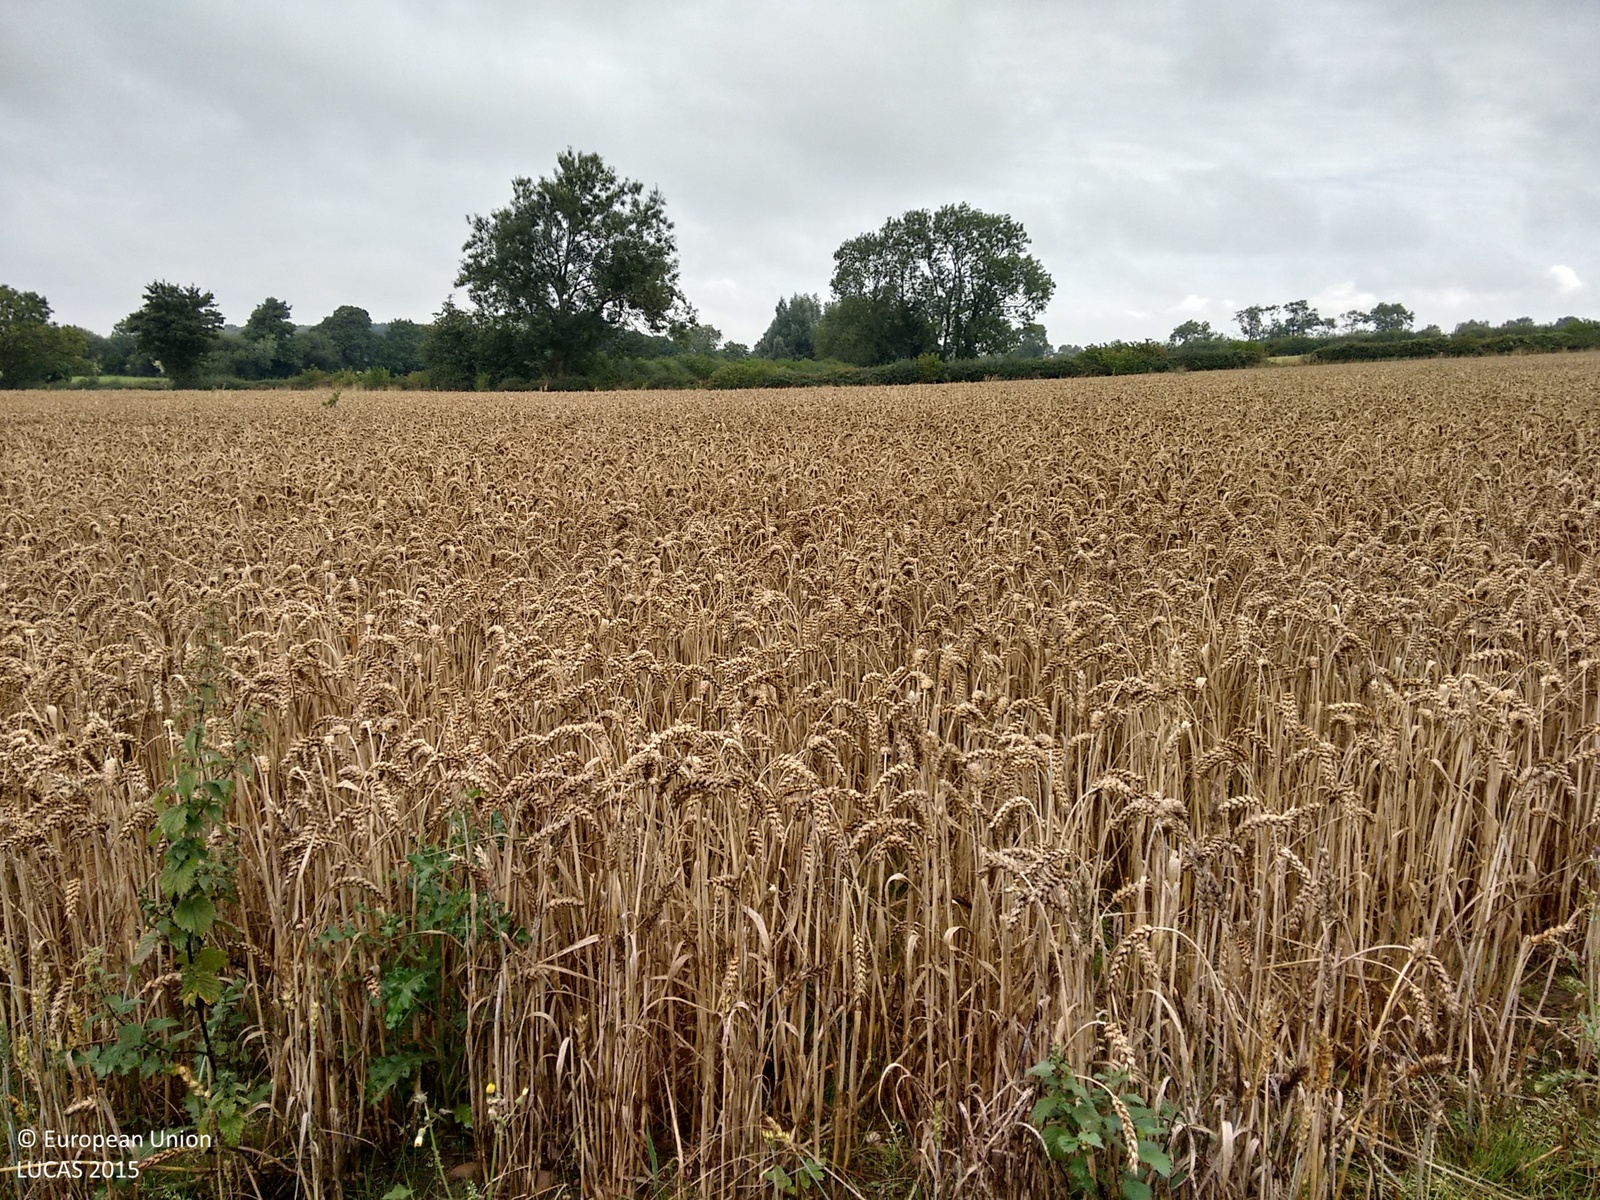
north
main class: Grassland
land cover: Grassland without tree/shrub cover
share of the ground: > 75 %
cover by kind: herbaceous plants 100 %
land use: Agriculture (excluding fallow land and kitchen gardens)
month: September
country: GB
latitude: 52.5061
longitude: -1.3190
